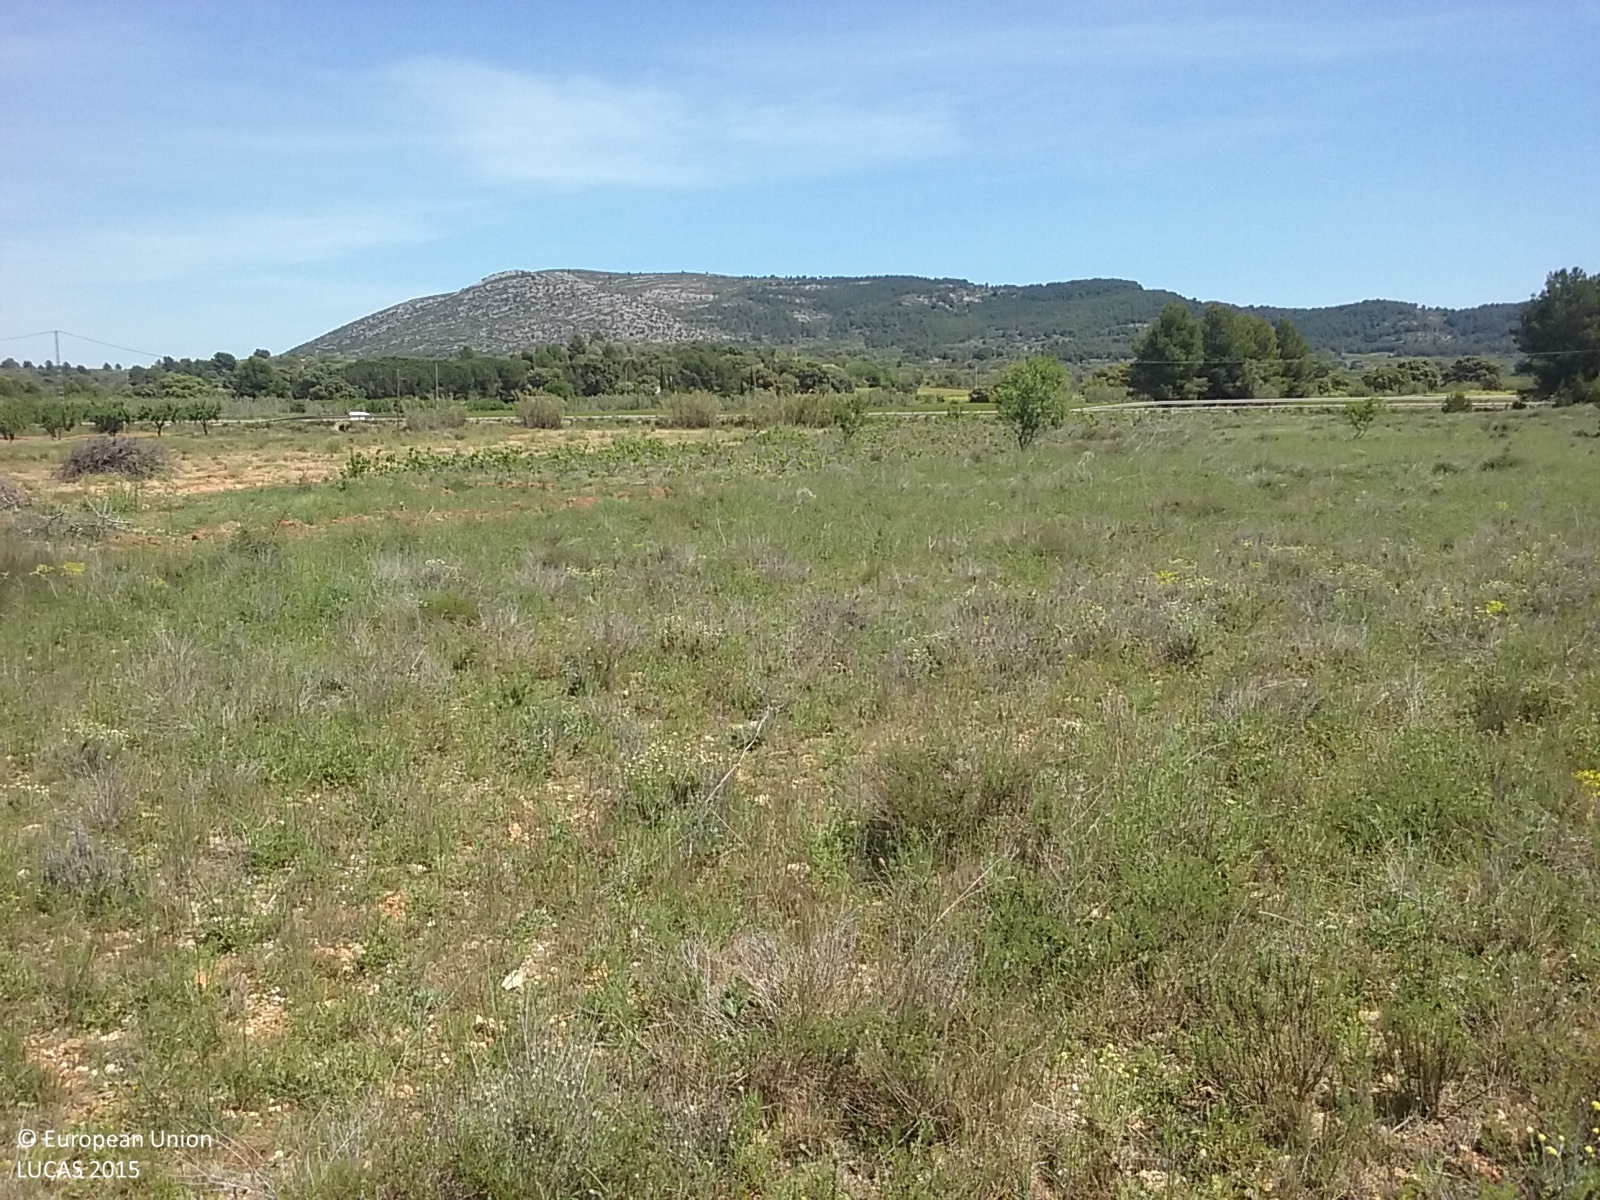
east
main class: Grassland
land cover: Spontaneously vegetated surfaces
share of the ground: > 75 %
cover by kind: herbaceous plants 95 %, shrubs 5 %
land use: Abandoned areas
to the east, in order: Spontaneously vegetated surfaces; Vineyards; Grass margins; Nuts trees; Electric lines; Shruby margins; Paved roads, cycling and walking lanes; Shruby margins; Tracks; Shruby margins; Barley
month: May
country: ES
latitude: 40.1363
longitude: -0.0137
